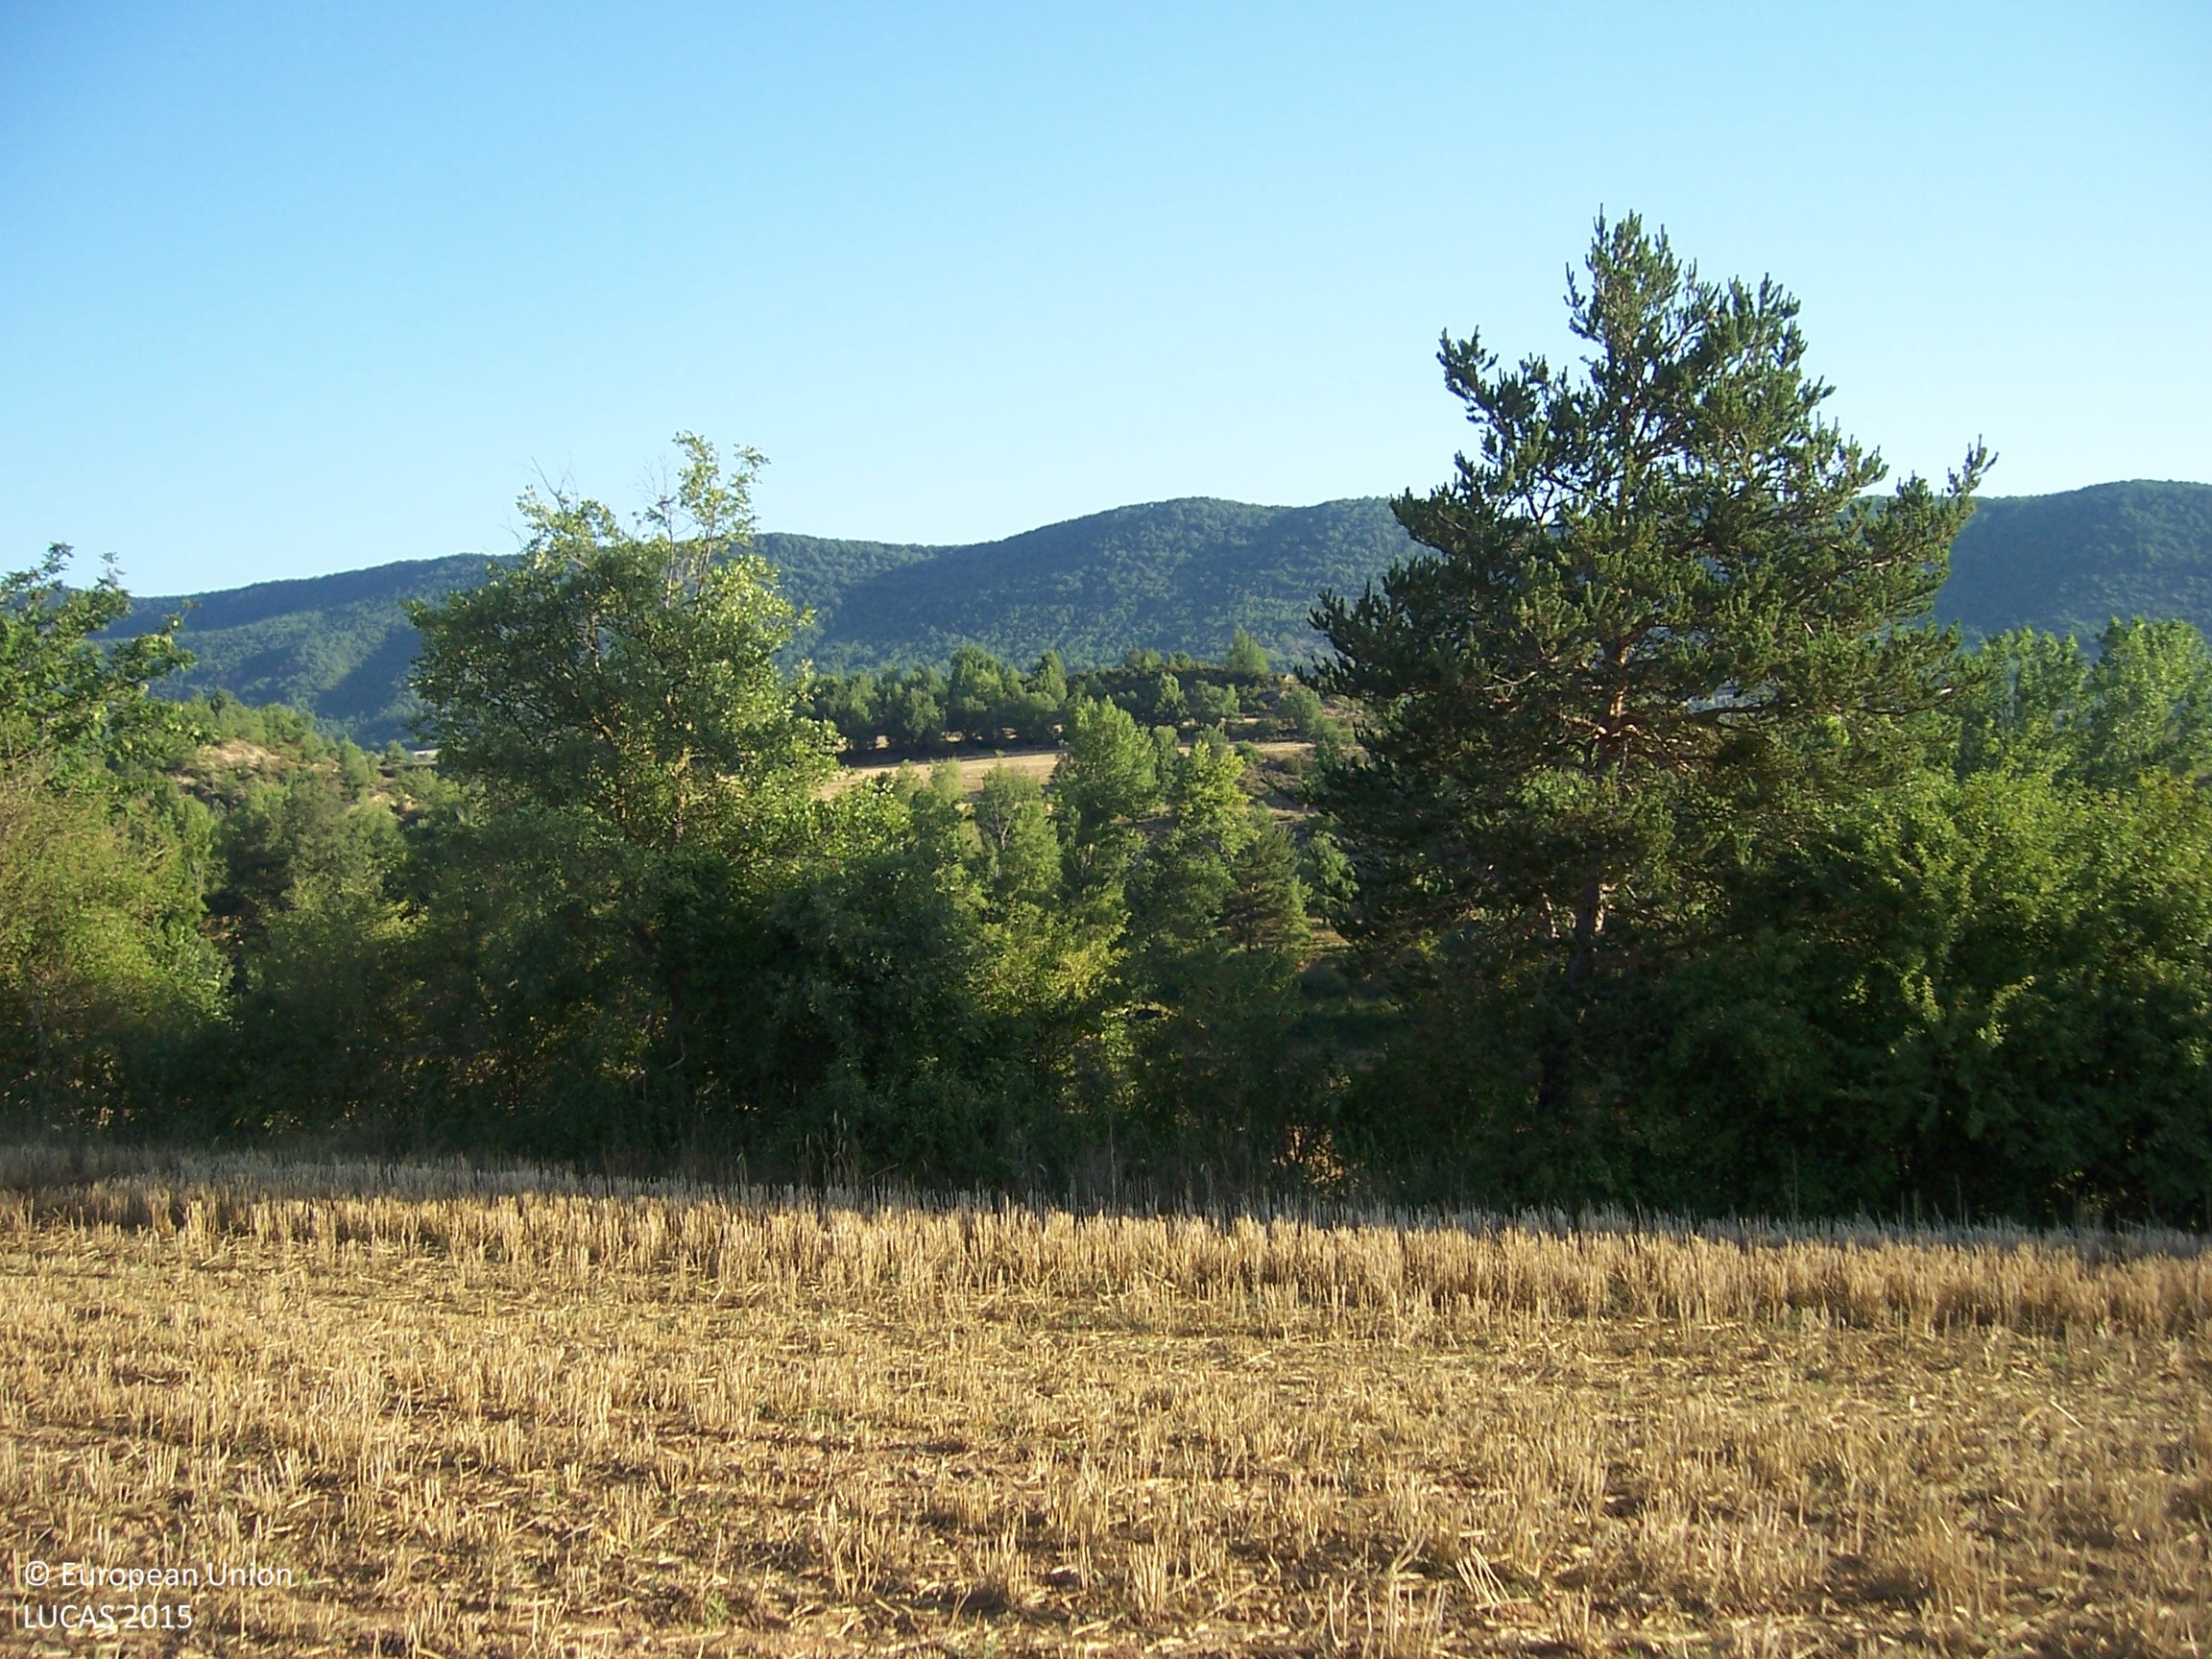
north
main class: Cropland
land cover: Barley
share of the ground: < 10 %
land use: Agriculture (excluding fallow land and kitchen gardens)
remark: Harvested field
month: August
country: ES
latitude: 42.4963
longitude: -0.4291
